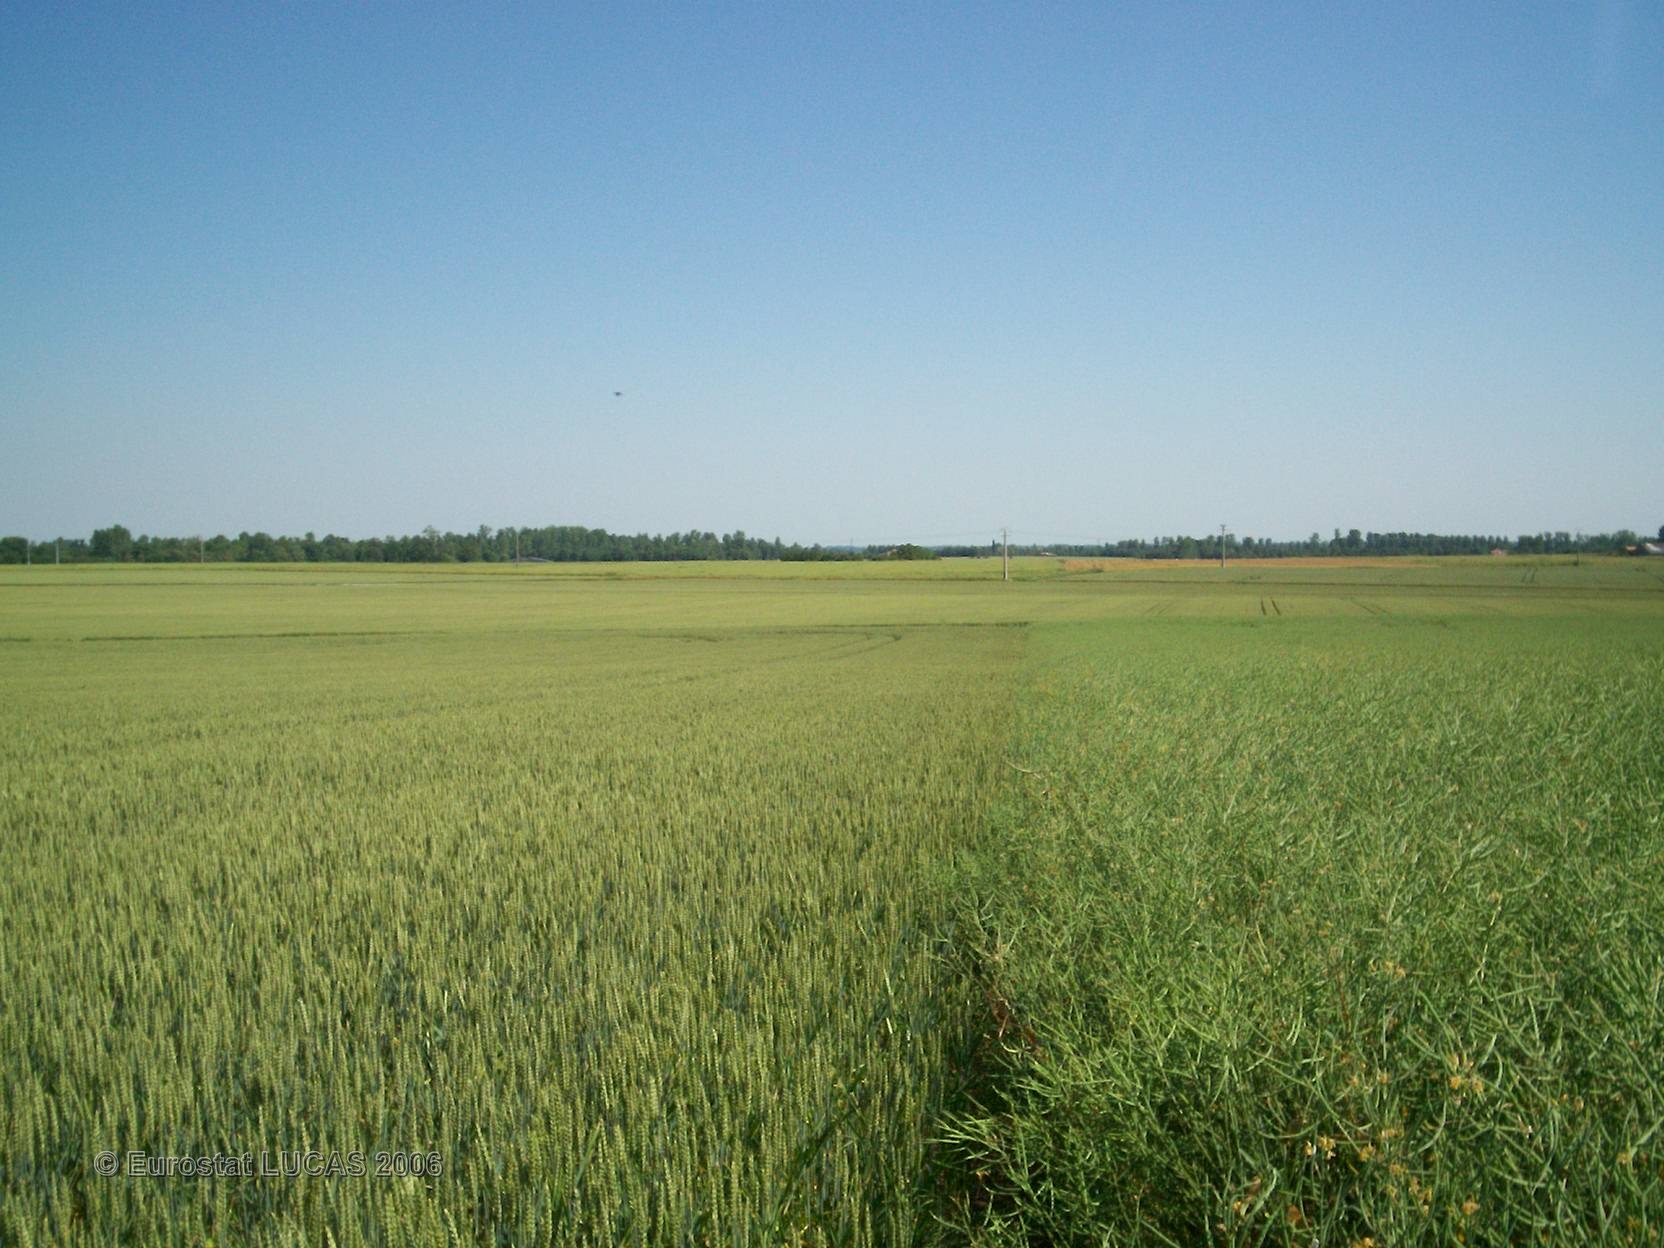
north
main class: Cropland
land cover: Rape and turnip rape
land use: Agriculture (excluding fallow land and kitchen gardens)
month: June
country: FR
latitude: 46.2408
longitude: -0.7793
